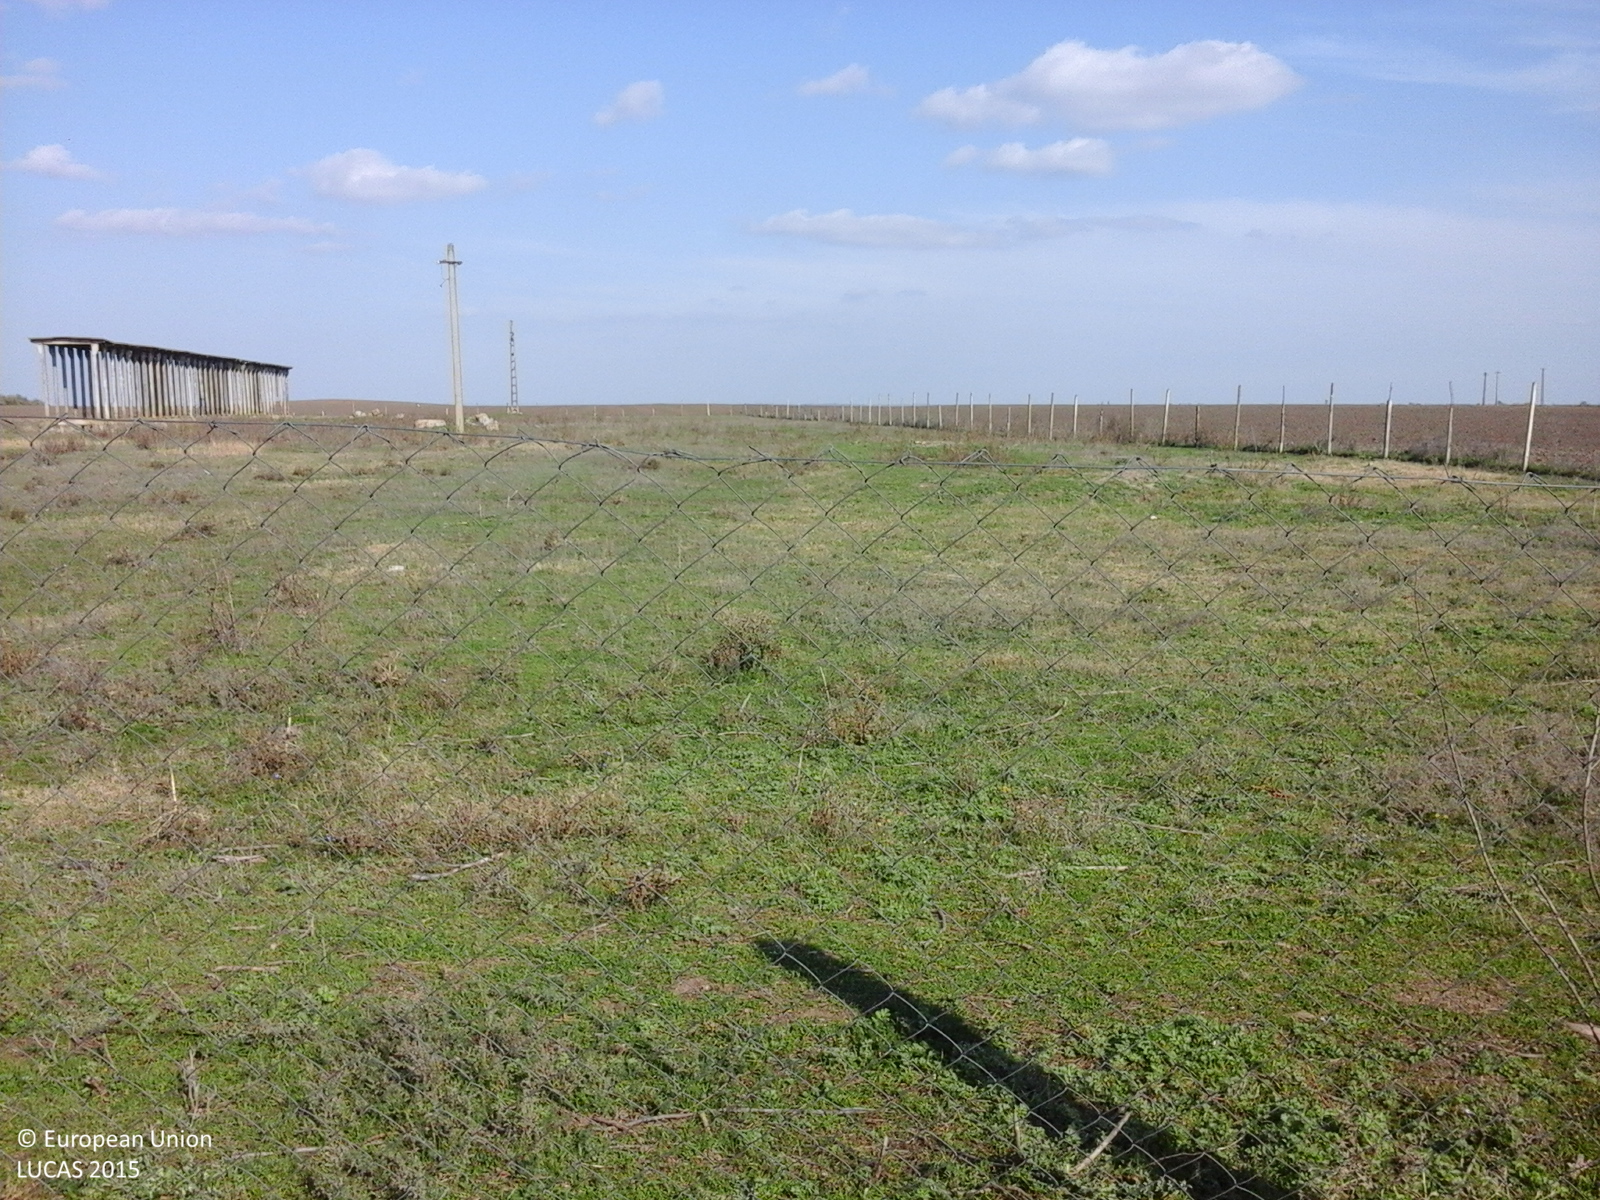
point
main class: Grassland
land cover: Spontaneously vegetated surfaces
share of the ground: > 75 %
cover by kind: herbaceous plants 100 %
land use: Fallow land
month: October
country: RO
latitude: 45.2306
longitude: 27.2494
